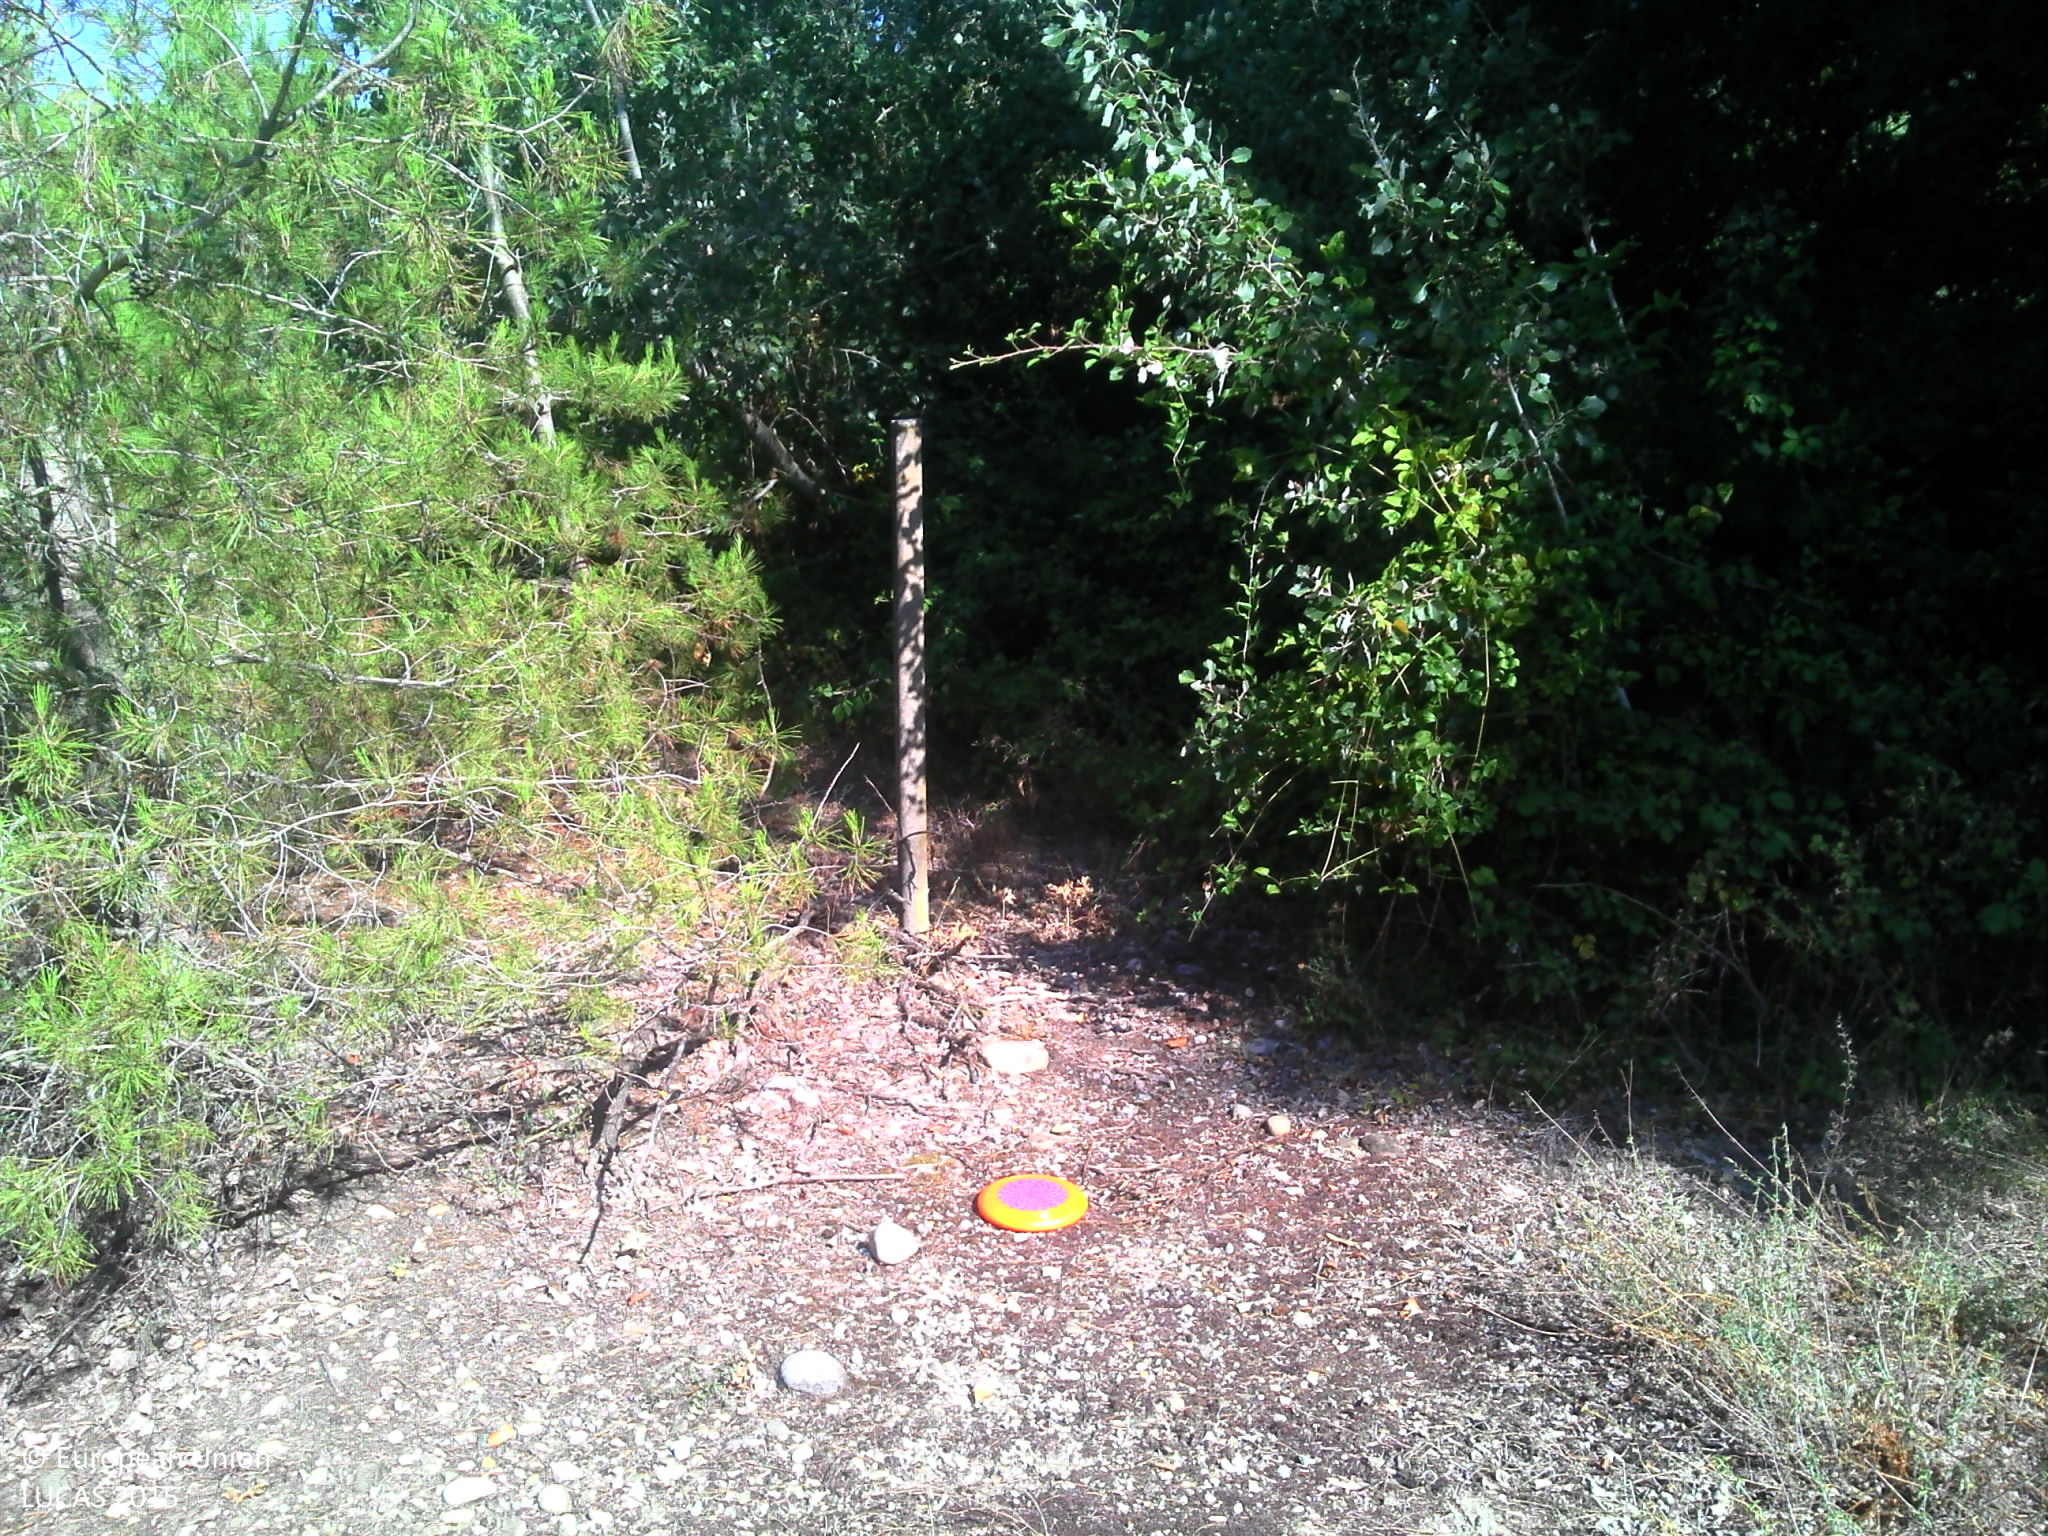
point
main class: Woodland
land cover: Broadleaved woodland
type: thermophilous deciduous forest
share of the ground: > 75 %
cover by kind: broadleaved forest trees 60 %, unconsolidated bare surface 20 %, shrubs 10 %, coniferous forest trees 5 %, herbaceous plants 5 %
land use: Semi-natural and natural areas not in use
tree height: > 5 m
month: August
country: FR
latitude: 43.6593
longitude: 5.5576
